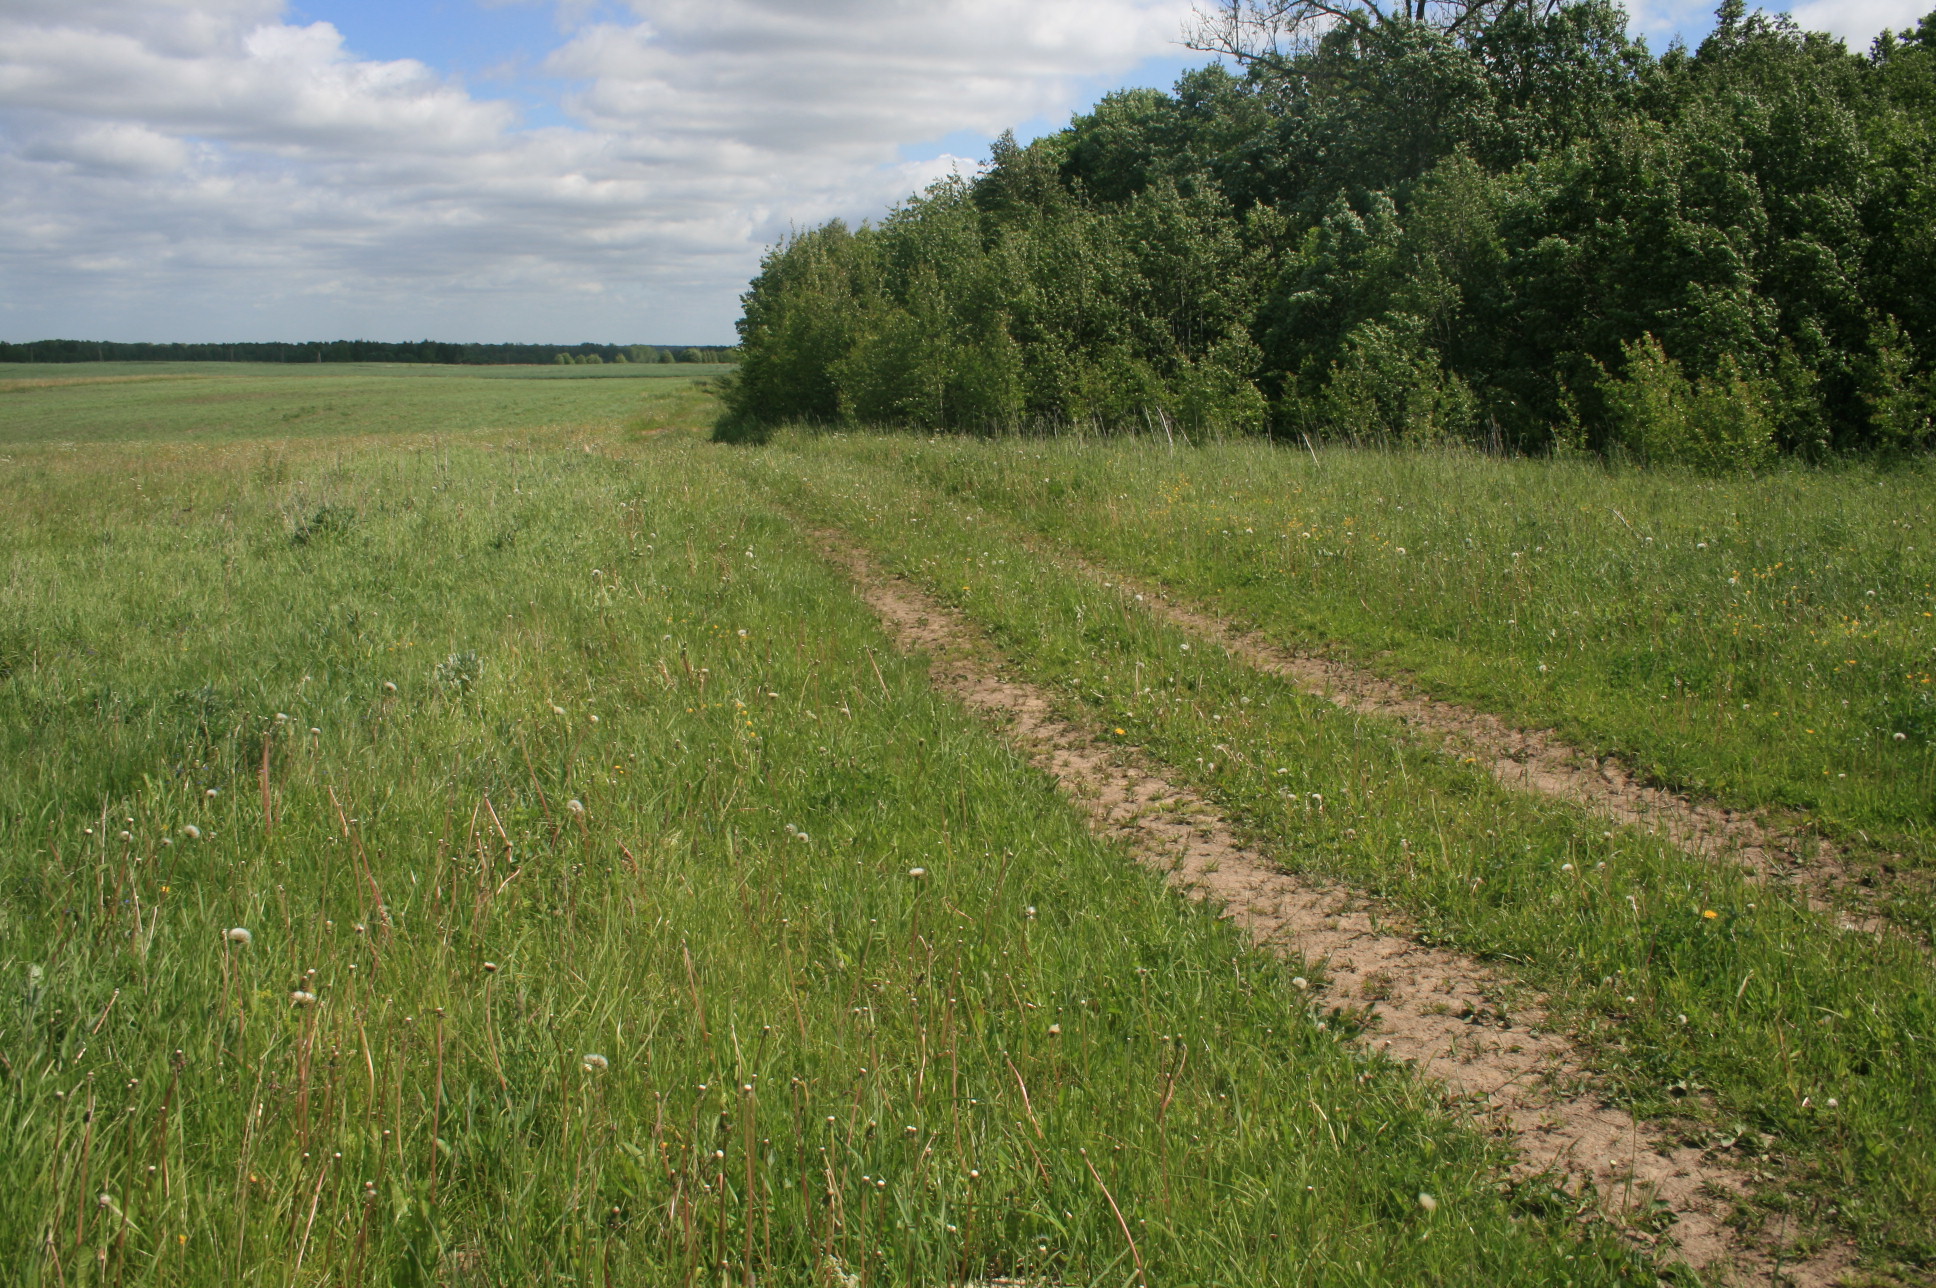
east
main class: Grassland
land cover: Grassland without tree/shrub cover
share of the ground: > 75 %
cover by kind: herbaceous plants 95 %, unconsolidated bare surface 5 %
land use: Agriculture (excluding fallow land and kitchen gardens)
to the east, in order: Grassland without tree/shrub cover; Tracks; Grass margins; Barley
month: June
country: LT
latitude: 56.0948
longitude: 22.3859
